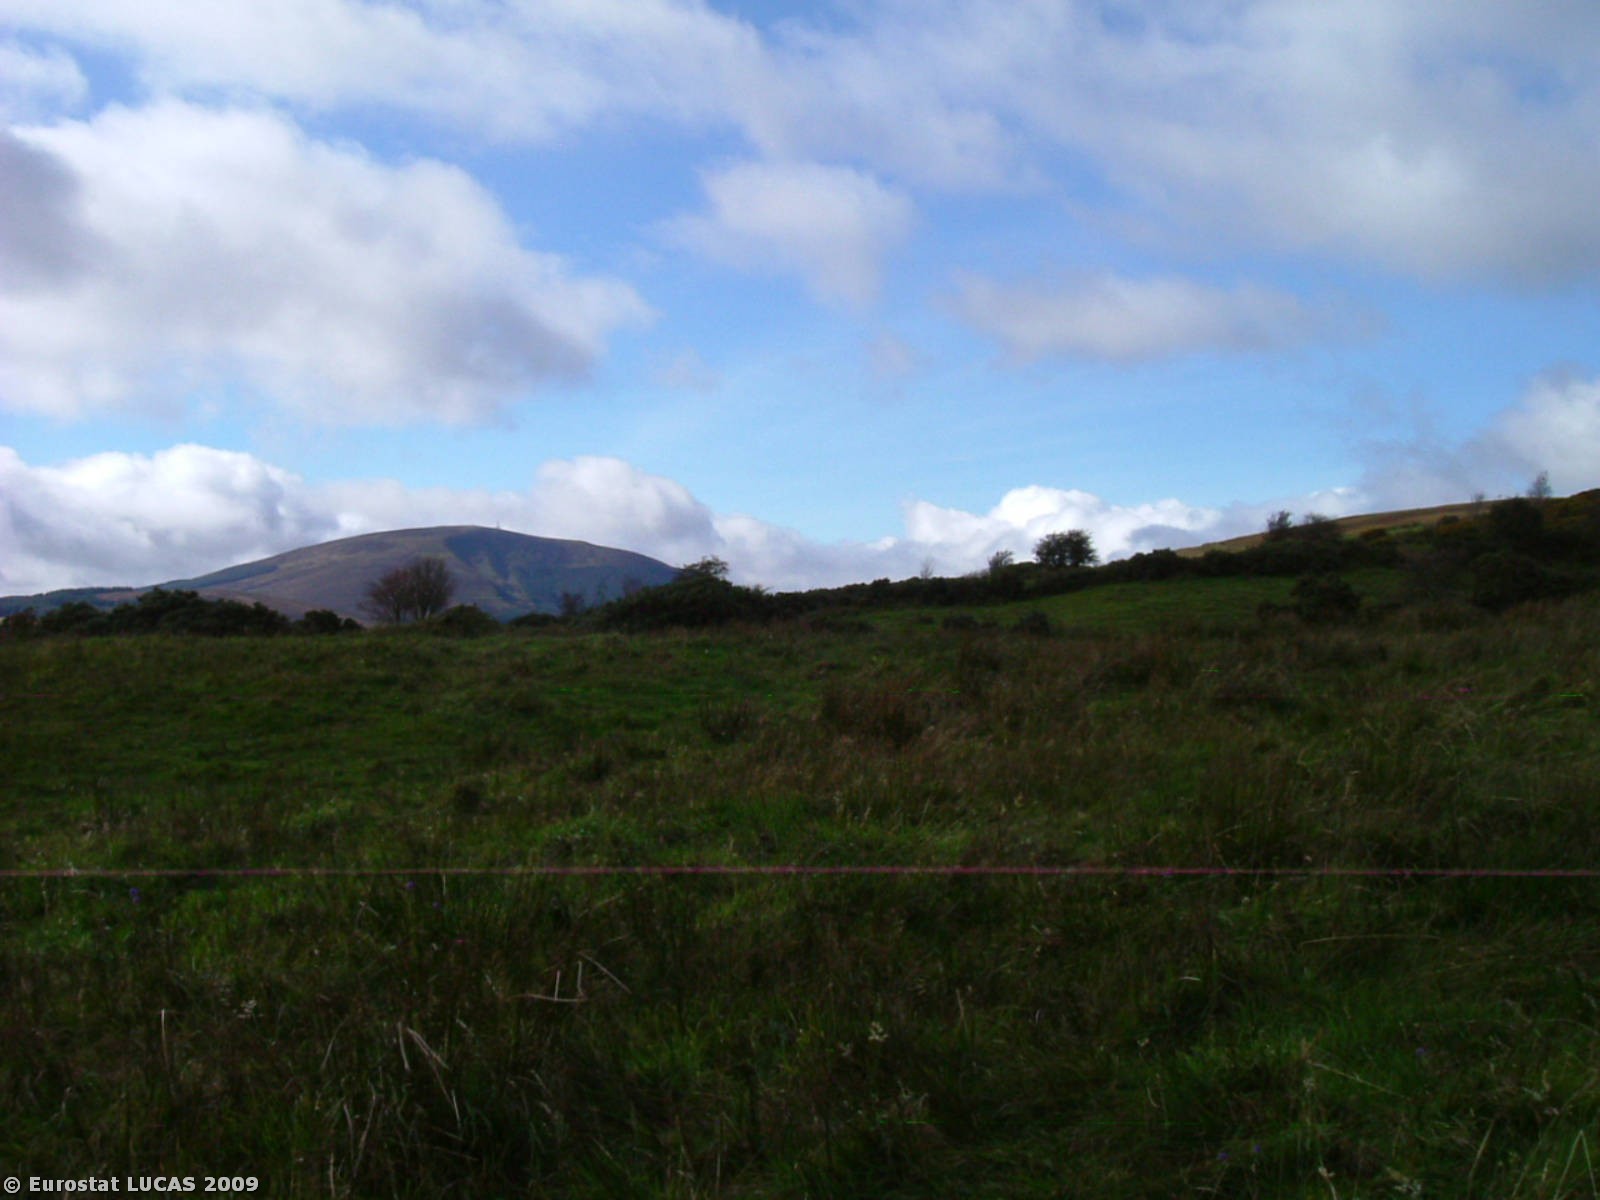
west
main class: Grassland
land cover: Grassland without tree/shrub cover
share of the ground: > 75 %
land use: Agriculture (excluding fallow land and kitchen gardens)
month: September
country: IE
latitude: 52.7637
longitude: -8.1885
